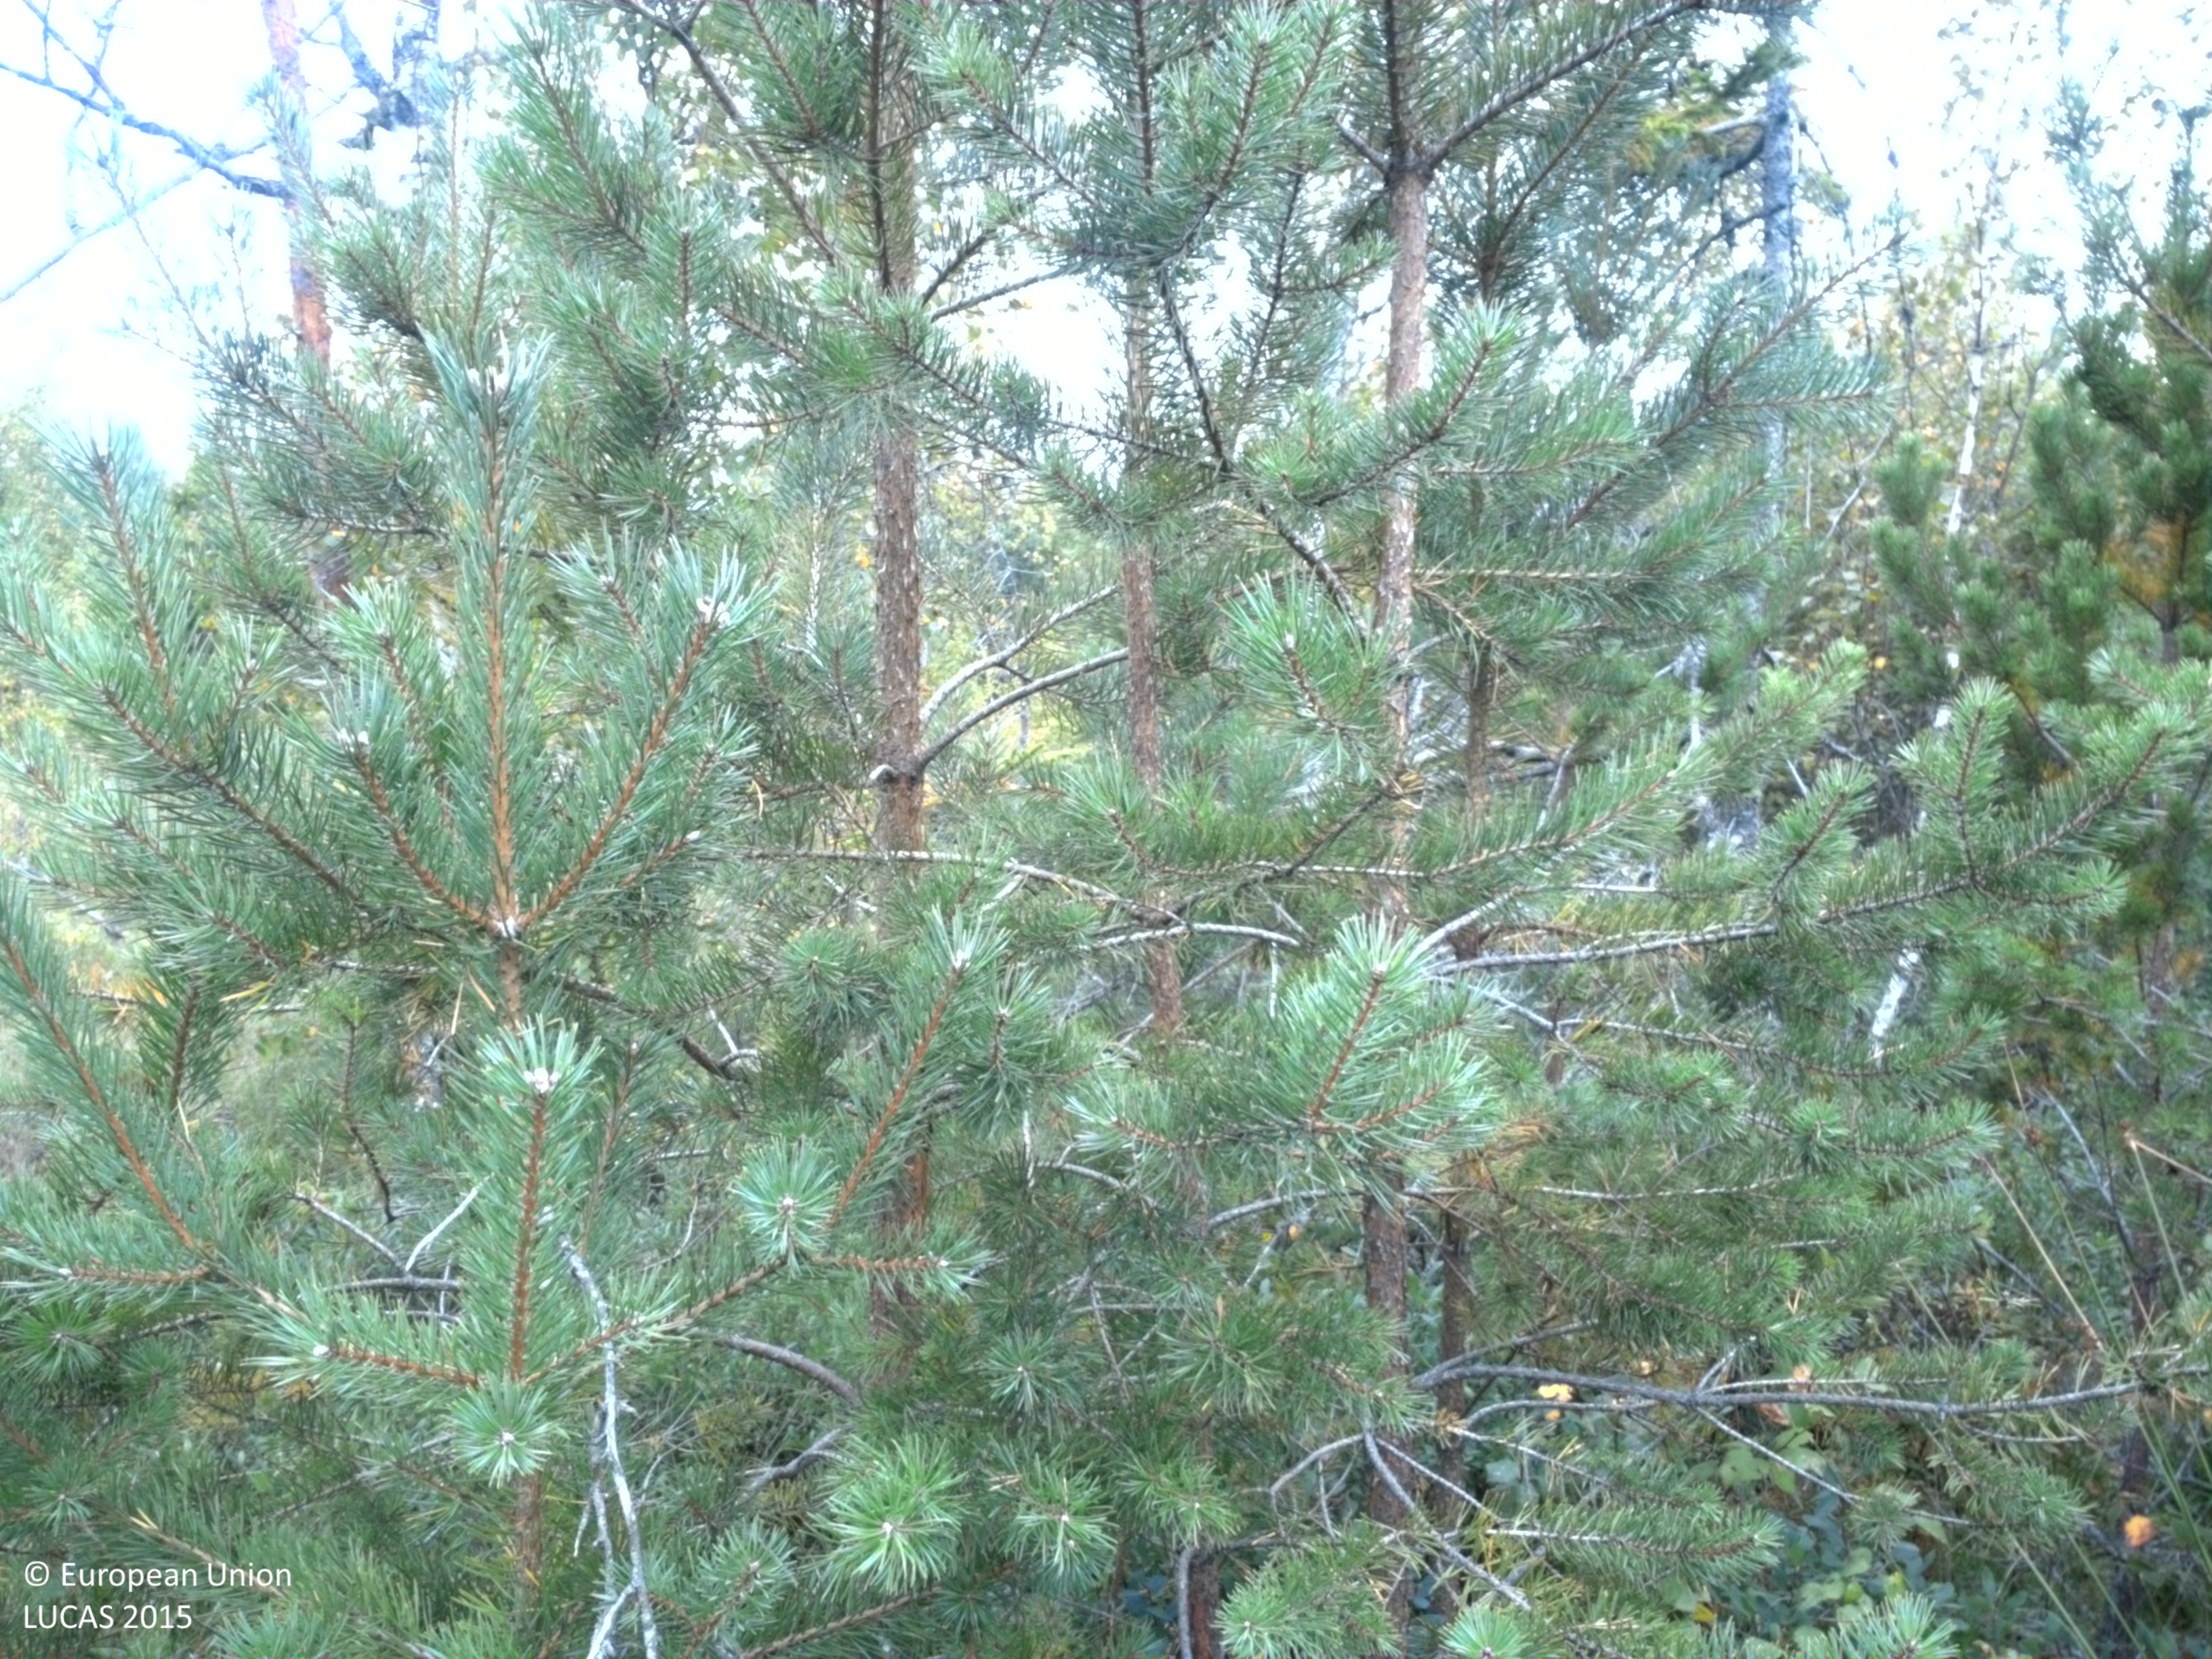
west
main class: Woodland
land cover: Pine dominated mixed woodland
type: boreal forest
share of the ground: 50 - 75 %
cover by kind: lichens and mosses 50 %, coniferous forest trees 35 %, broadleaved forest trees 15 %
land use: Forestry
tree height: < 5 m
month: August
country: SE
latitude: 59.5629
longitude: 17.1969
